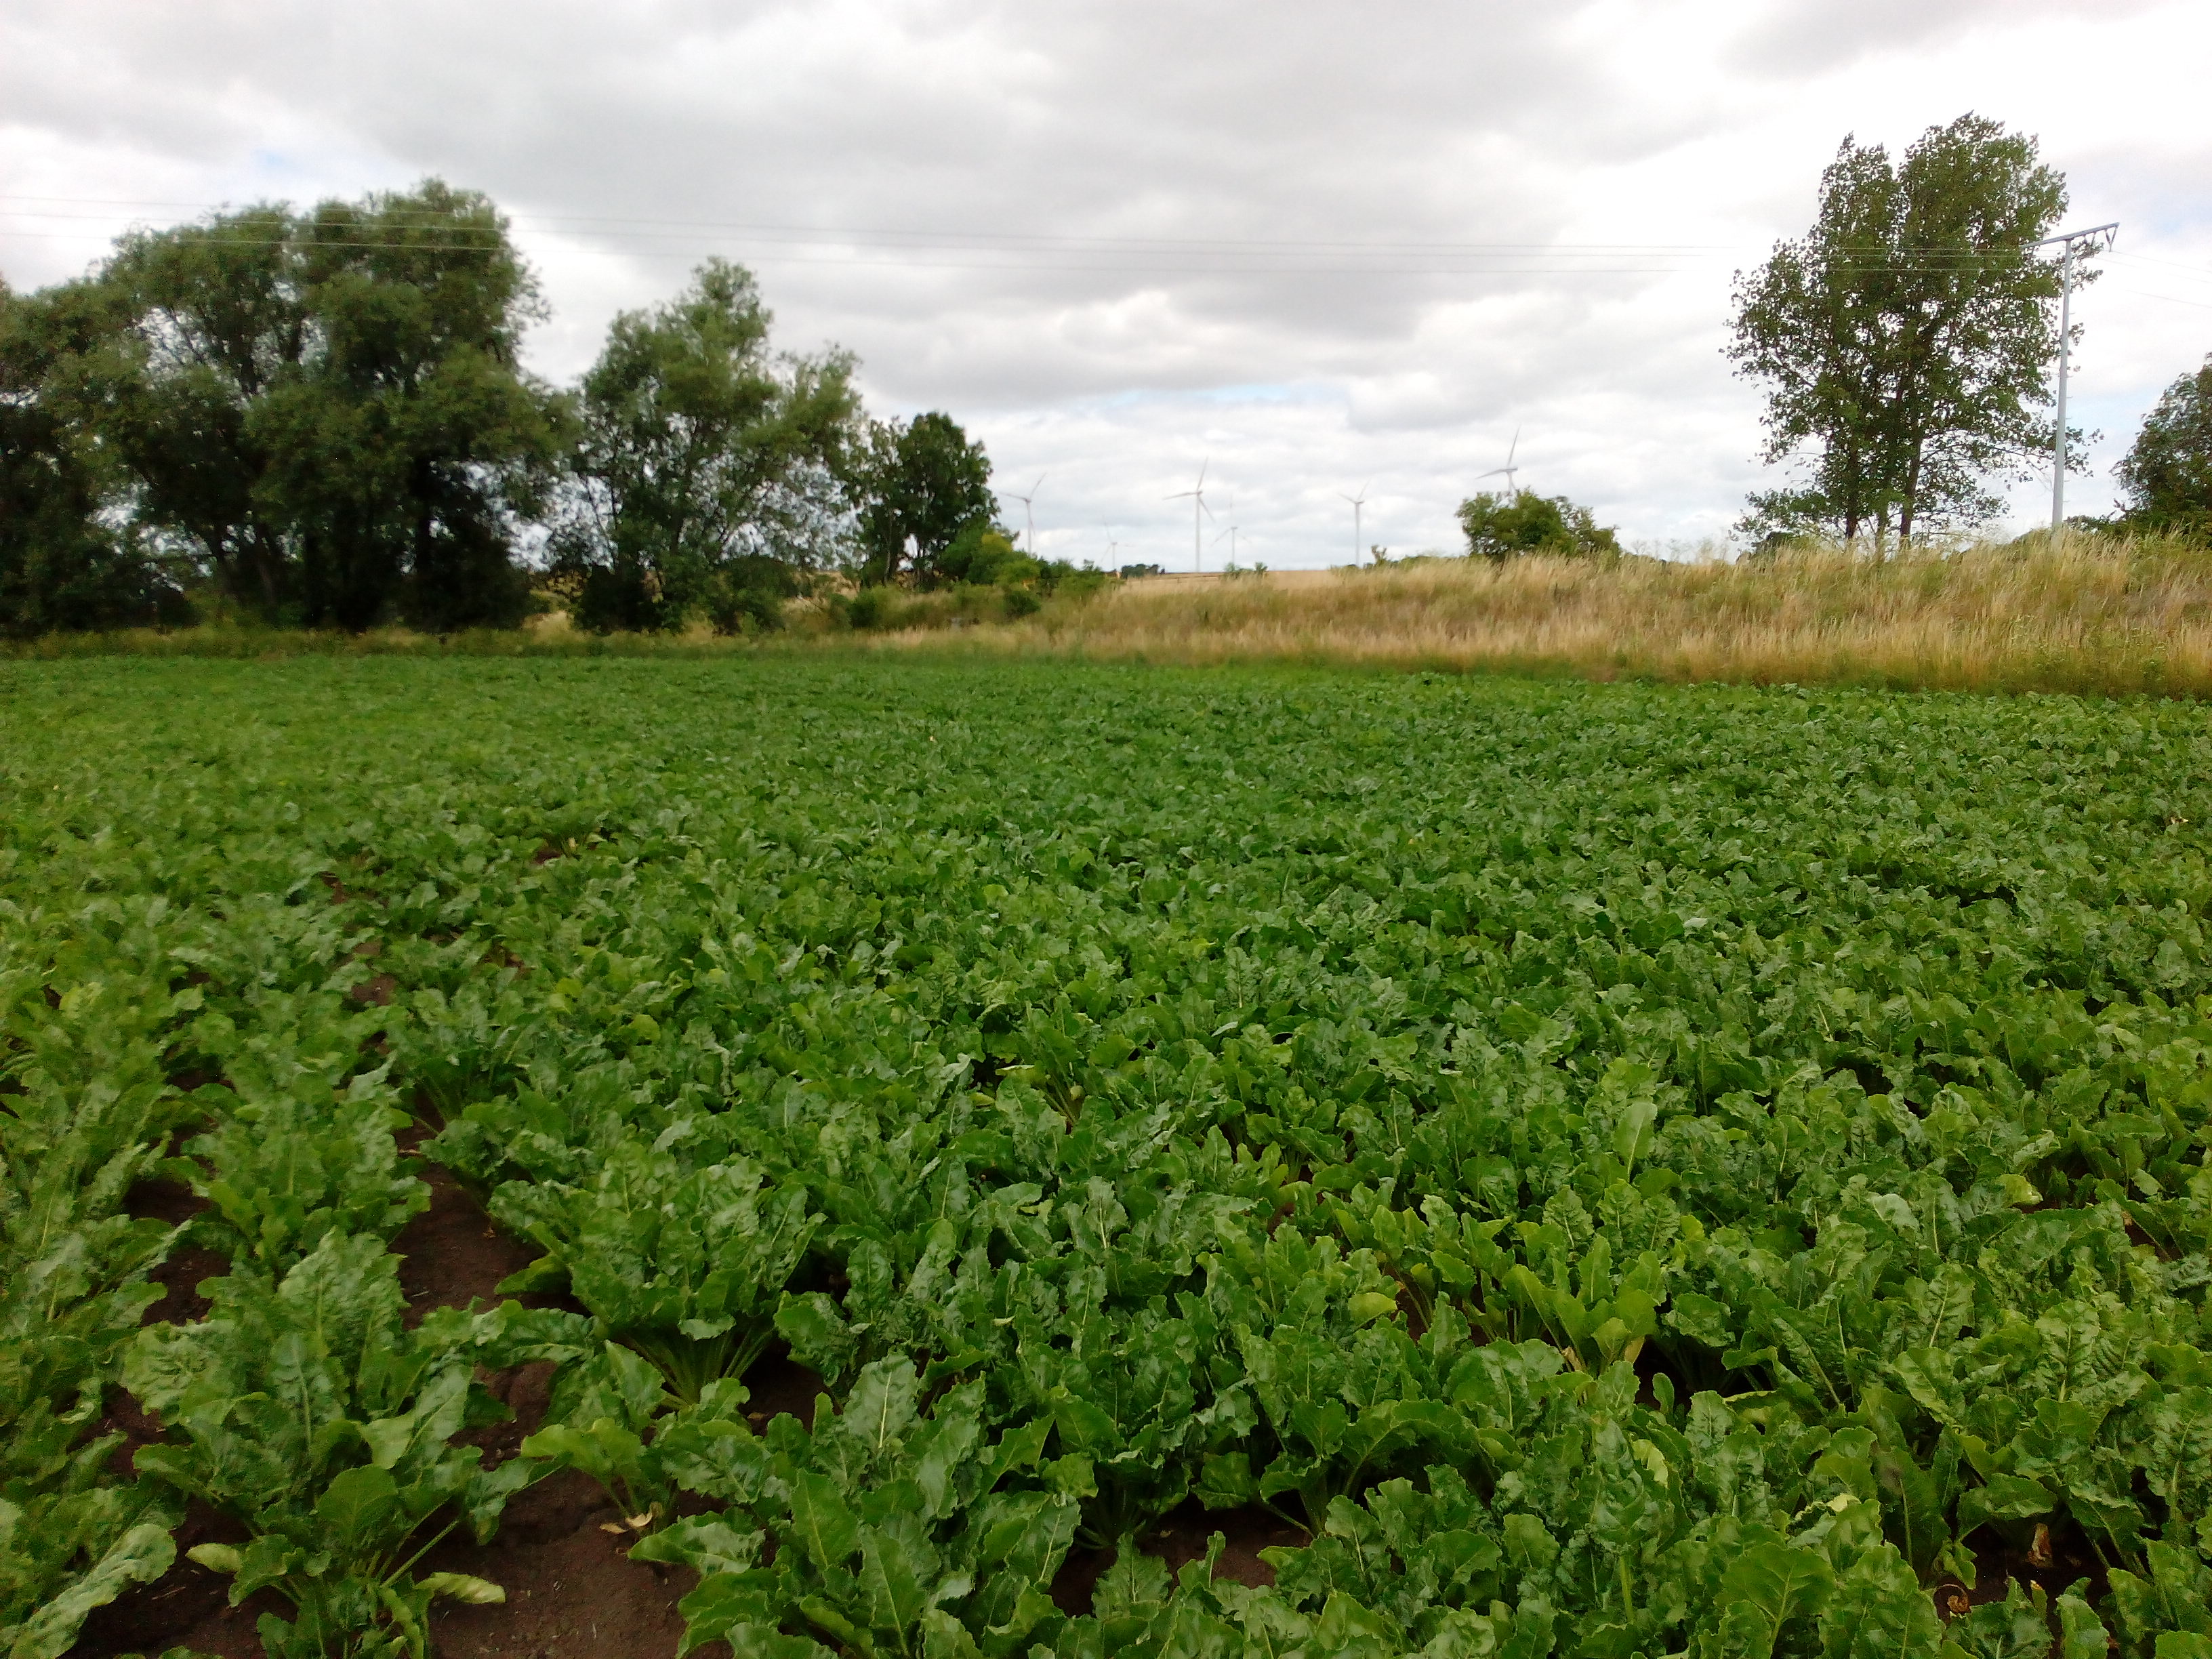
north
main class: Cropland
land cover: Sugar beet
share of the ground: > 75 %
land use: Agriculture (excluding fallow land and kitchen gardens)
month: July
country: DE
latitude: 51.1871
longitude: 10.9583
